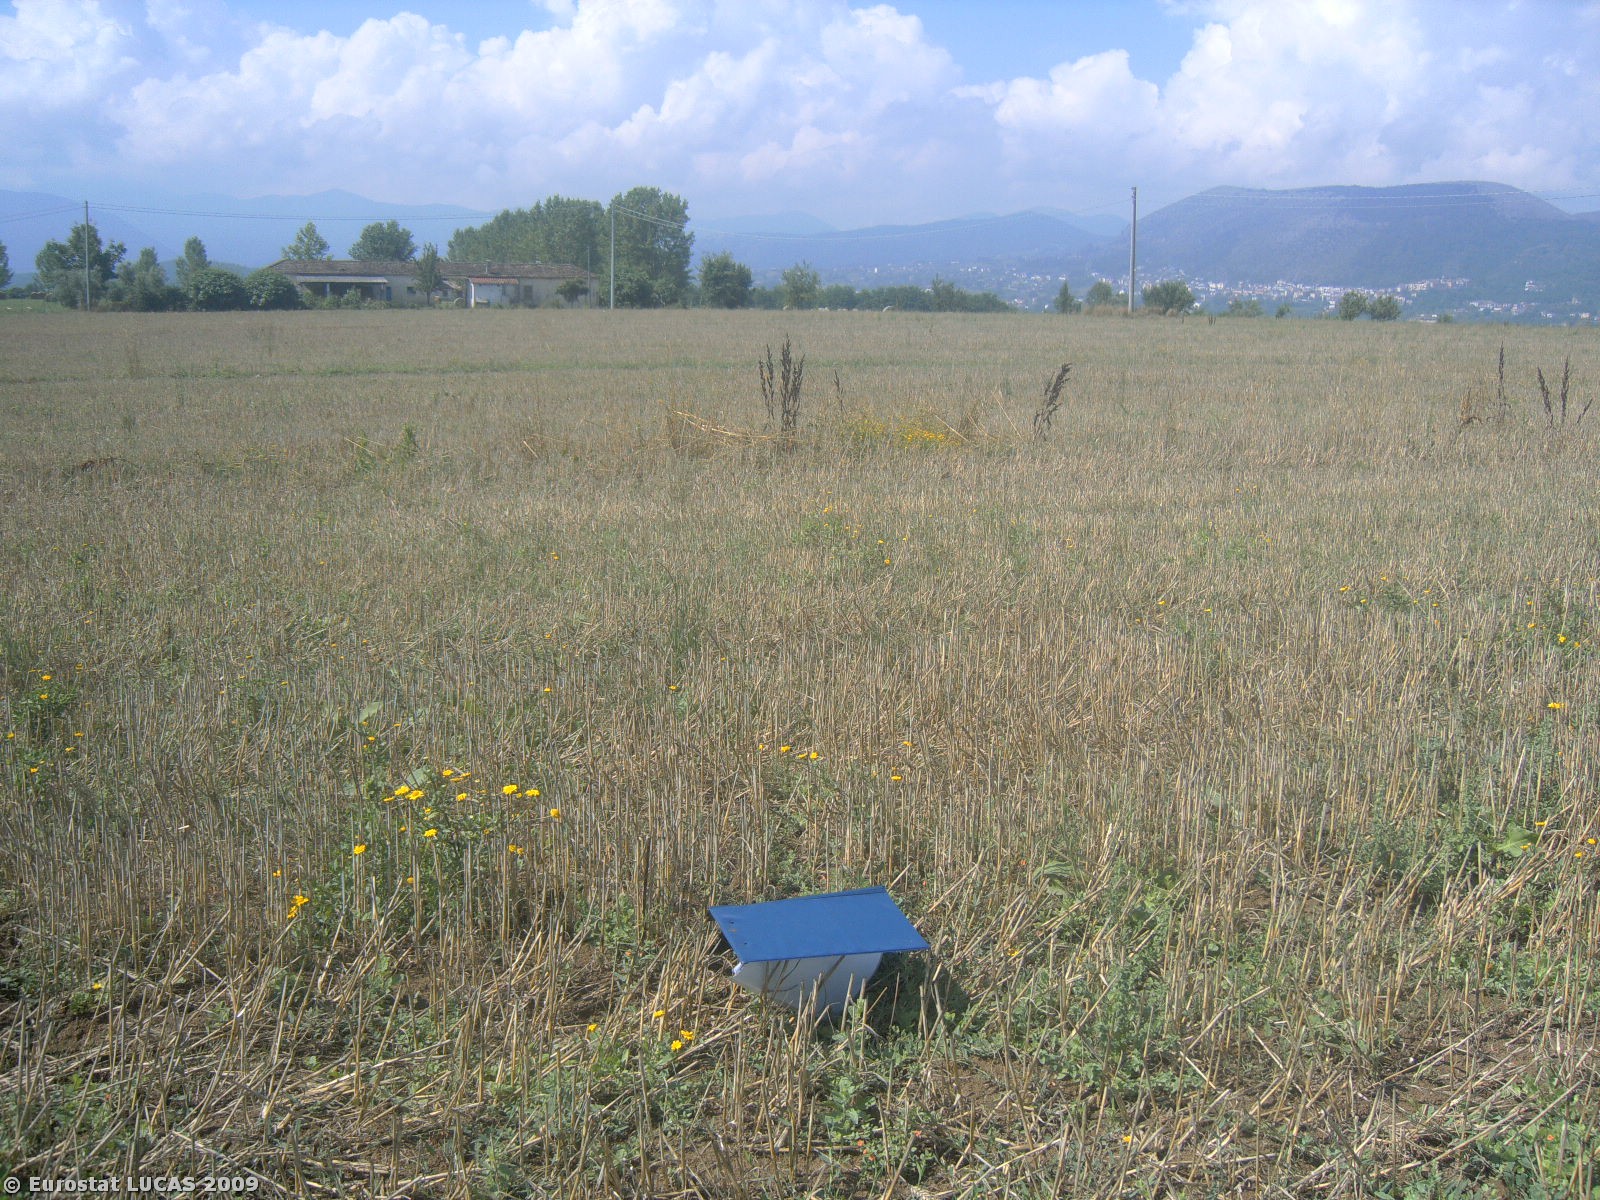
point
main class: Cropland
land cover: Common wheat
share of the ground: > 75 %
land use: Agriculture (excluding fallow land and kitchen gardens)
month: July
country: IT
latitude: 41.5232
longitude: 13.5934
